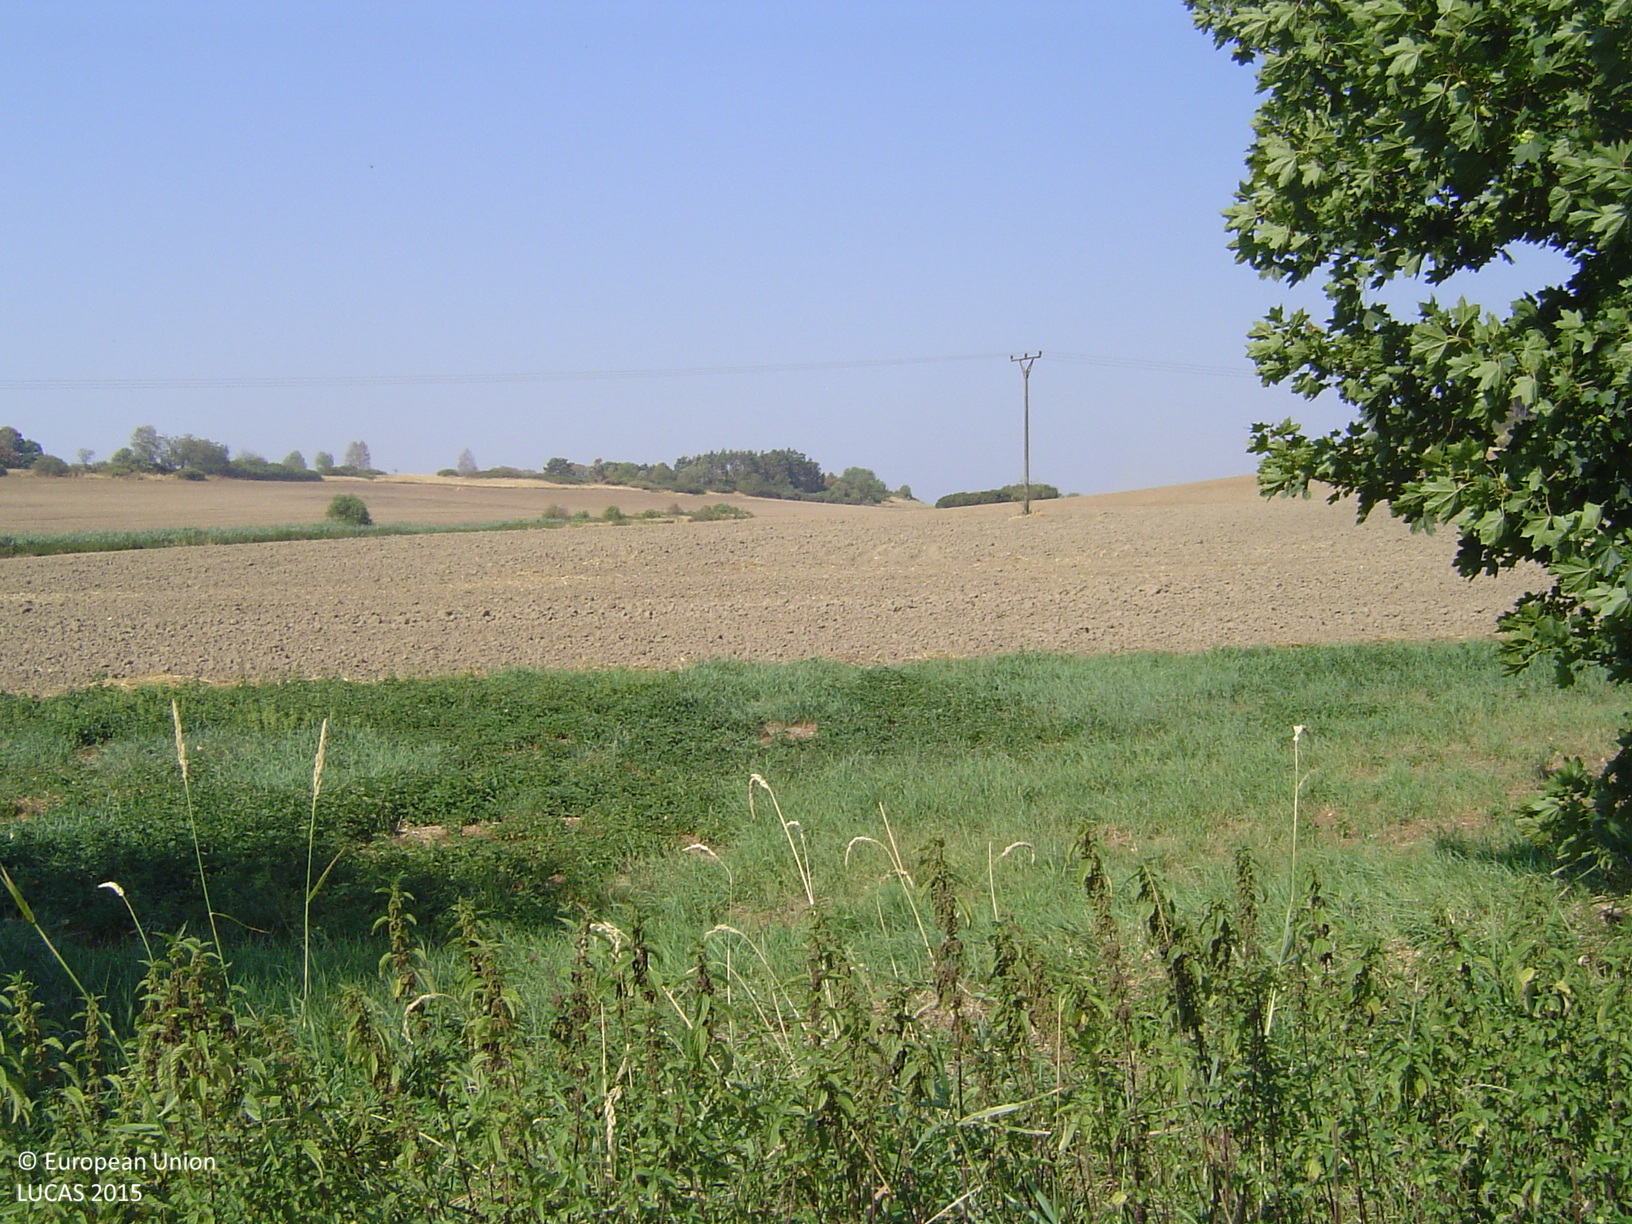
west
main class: Cropland
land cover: Barley
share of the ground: > 75 %
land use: Agriculture (excluding fallow land and kitchen gardens)
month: August
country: CZ
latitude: 49.6853
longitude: 14.3952
